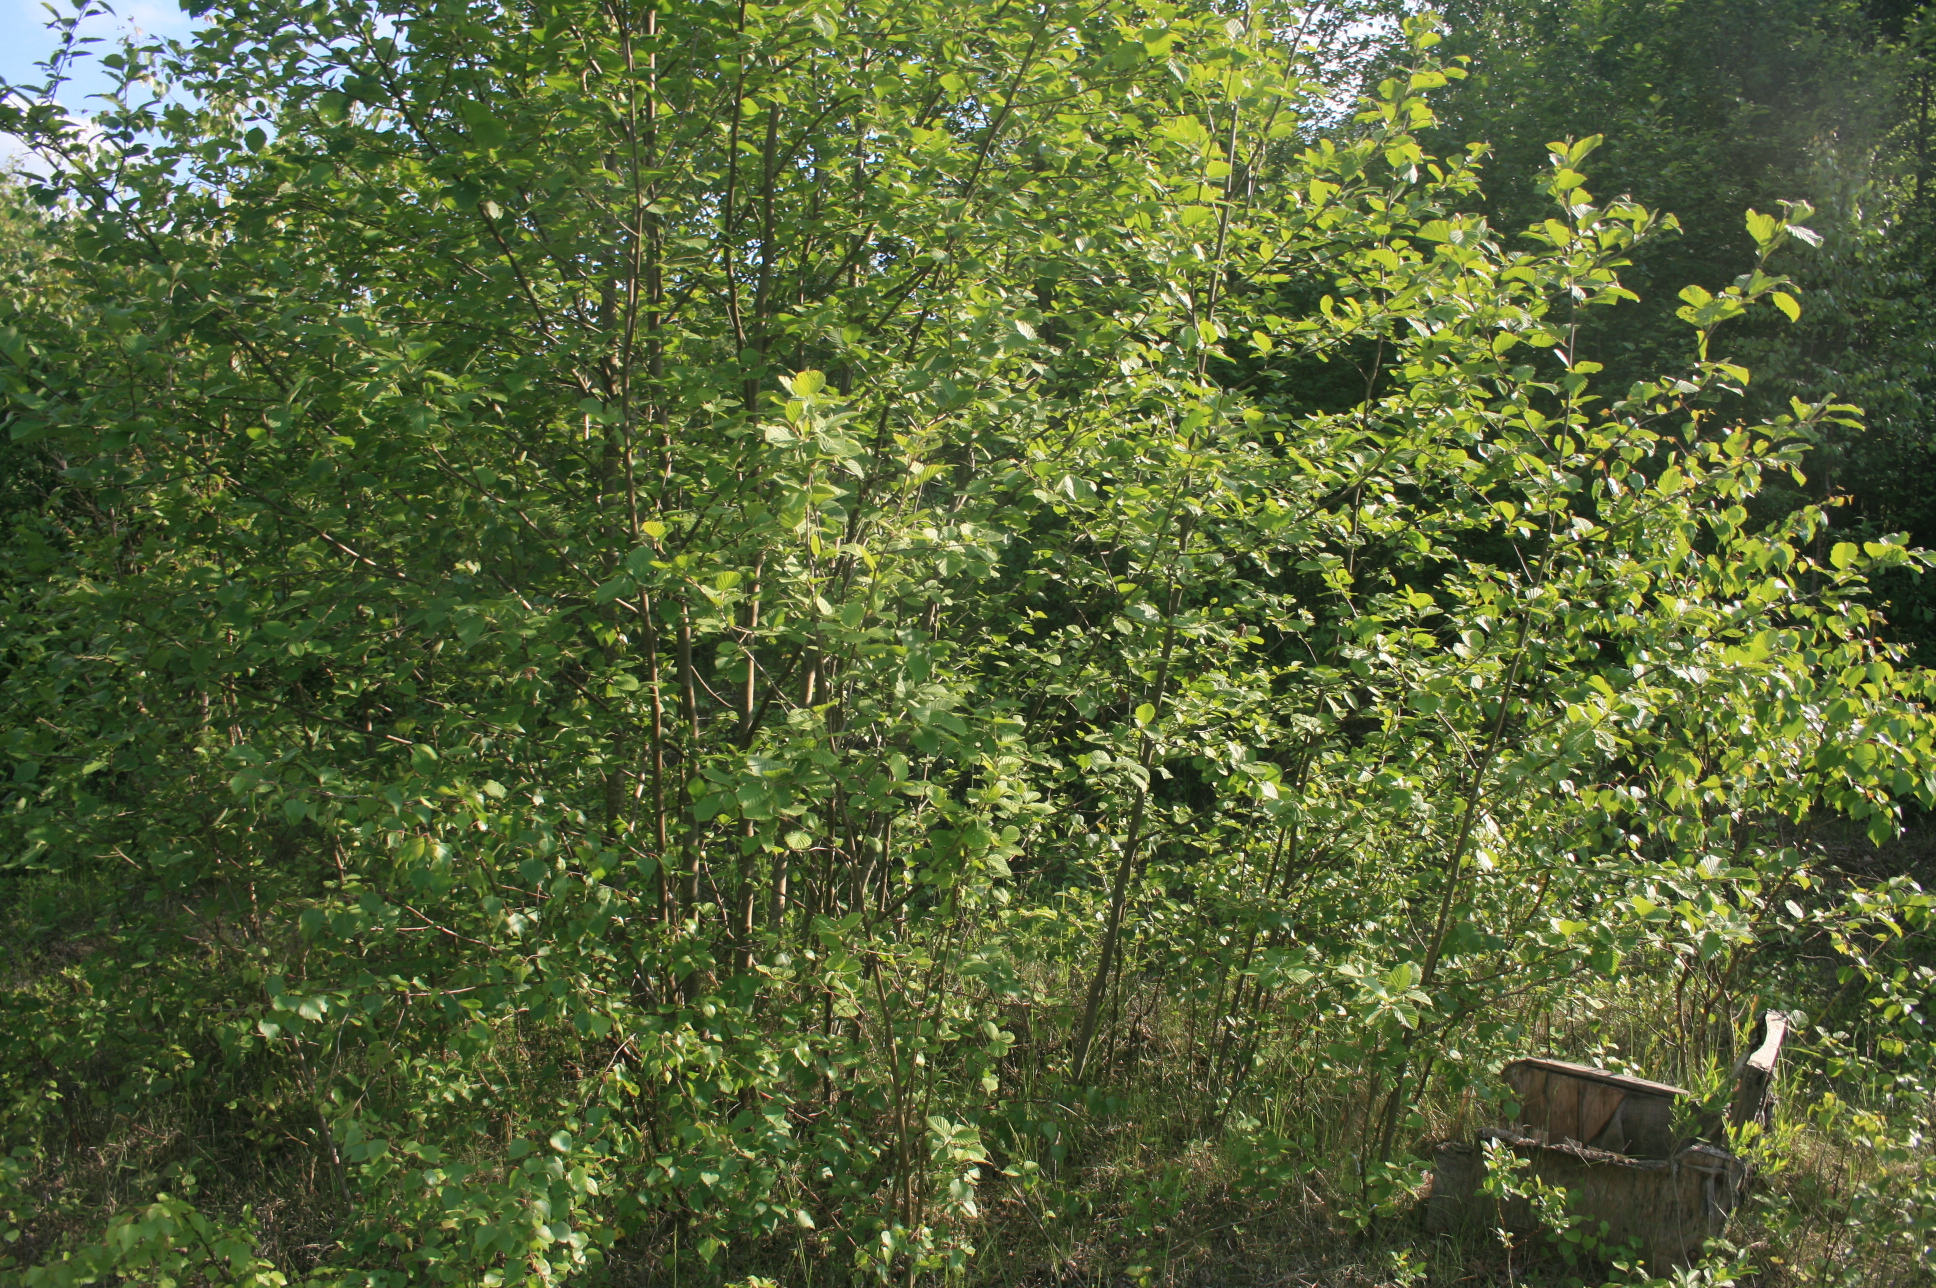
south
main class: Woodland
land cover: Broadleaved woodland
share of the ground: 50 - 75 %
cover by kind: broadleaved forest trees 60 %, herbaceous plants 25 %, unconsolidated bare surface 15 %
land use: Forestry
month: June
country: LT
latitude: 55.6385
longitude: 22.2091
